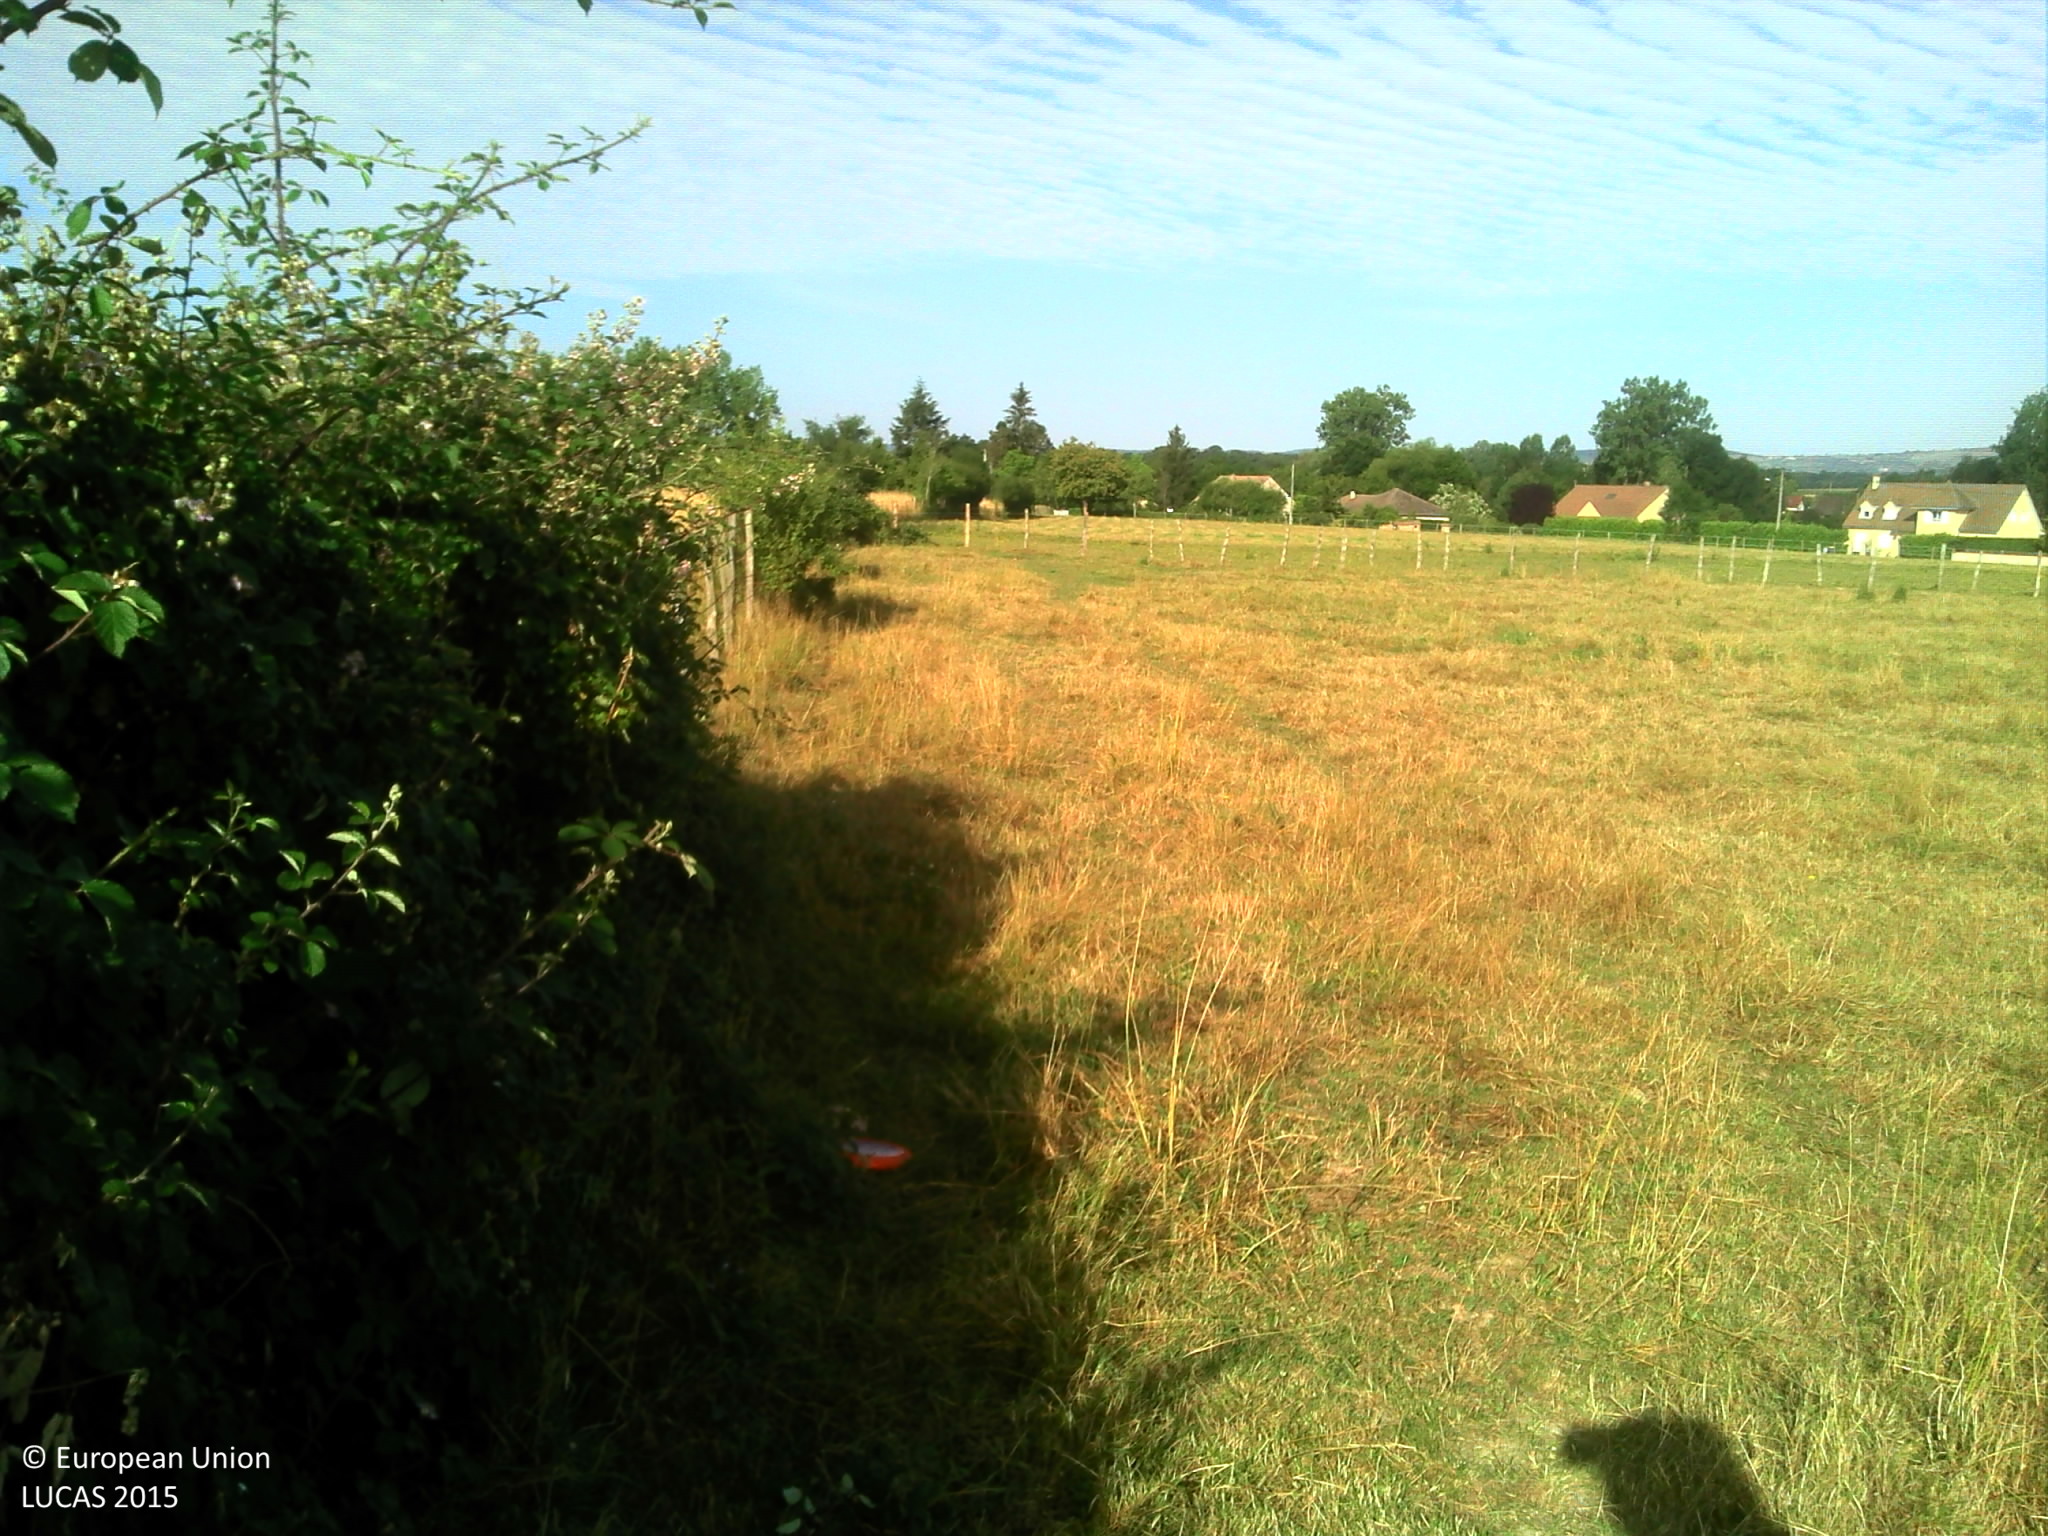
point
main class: Grassland
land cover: Grassland without tree/shrub cover
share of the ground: > 75 %
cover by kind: herbaceous plants 100 %
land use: Agriculture (excluding fallow land and kitchen gardens)
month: June
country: FR
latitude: 46.7303
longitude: 4.8064
